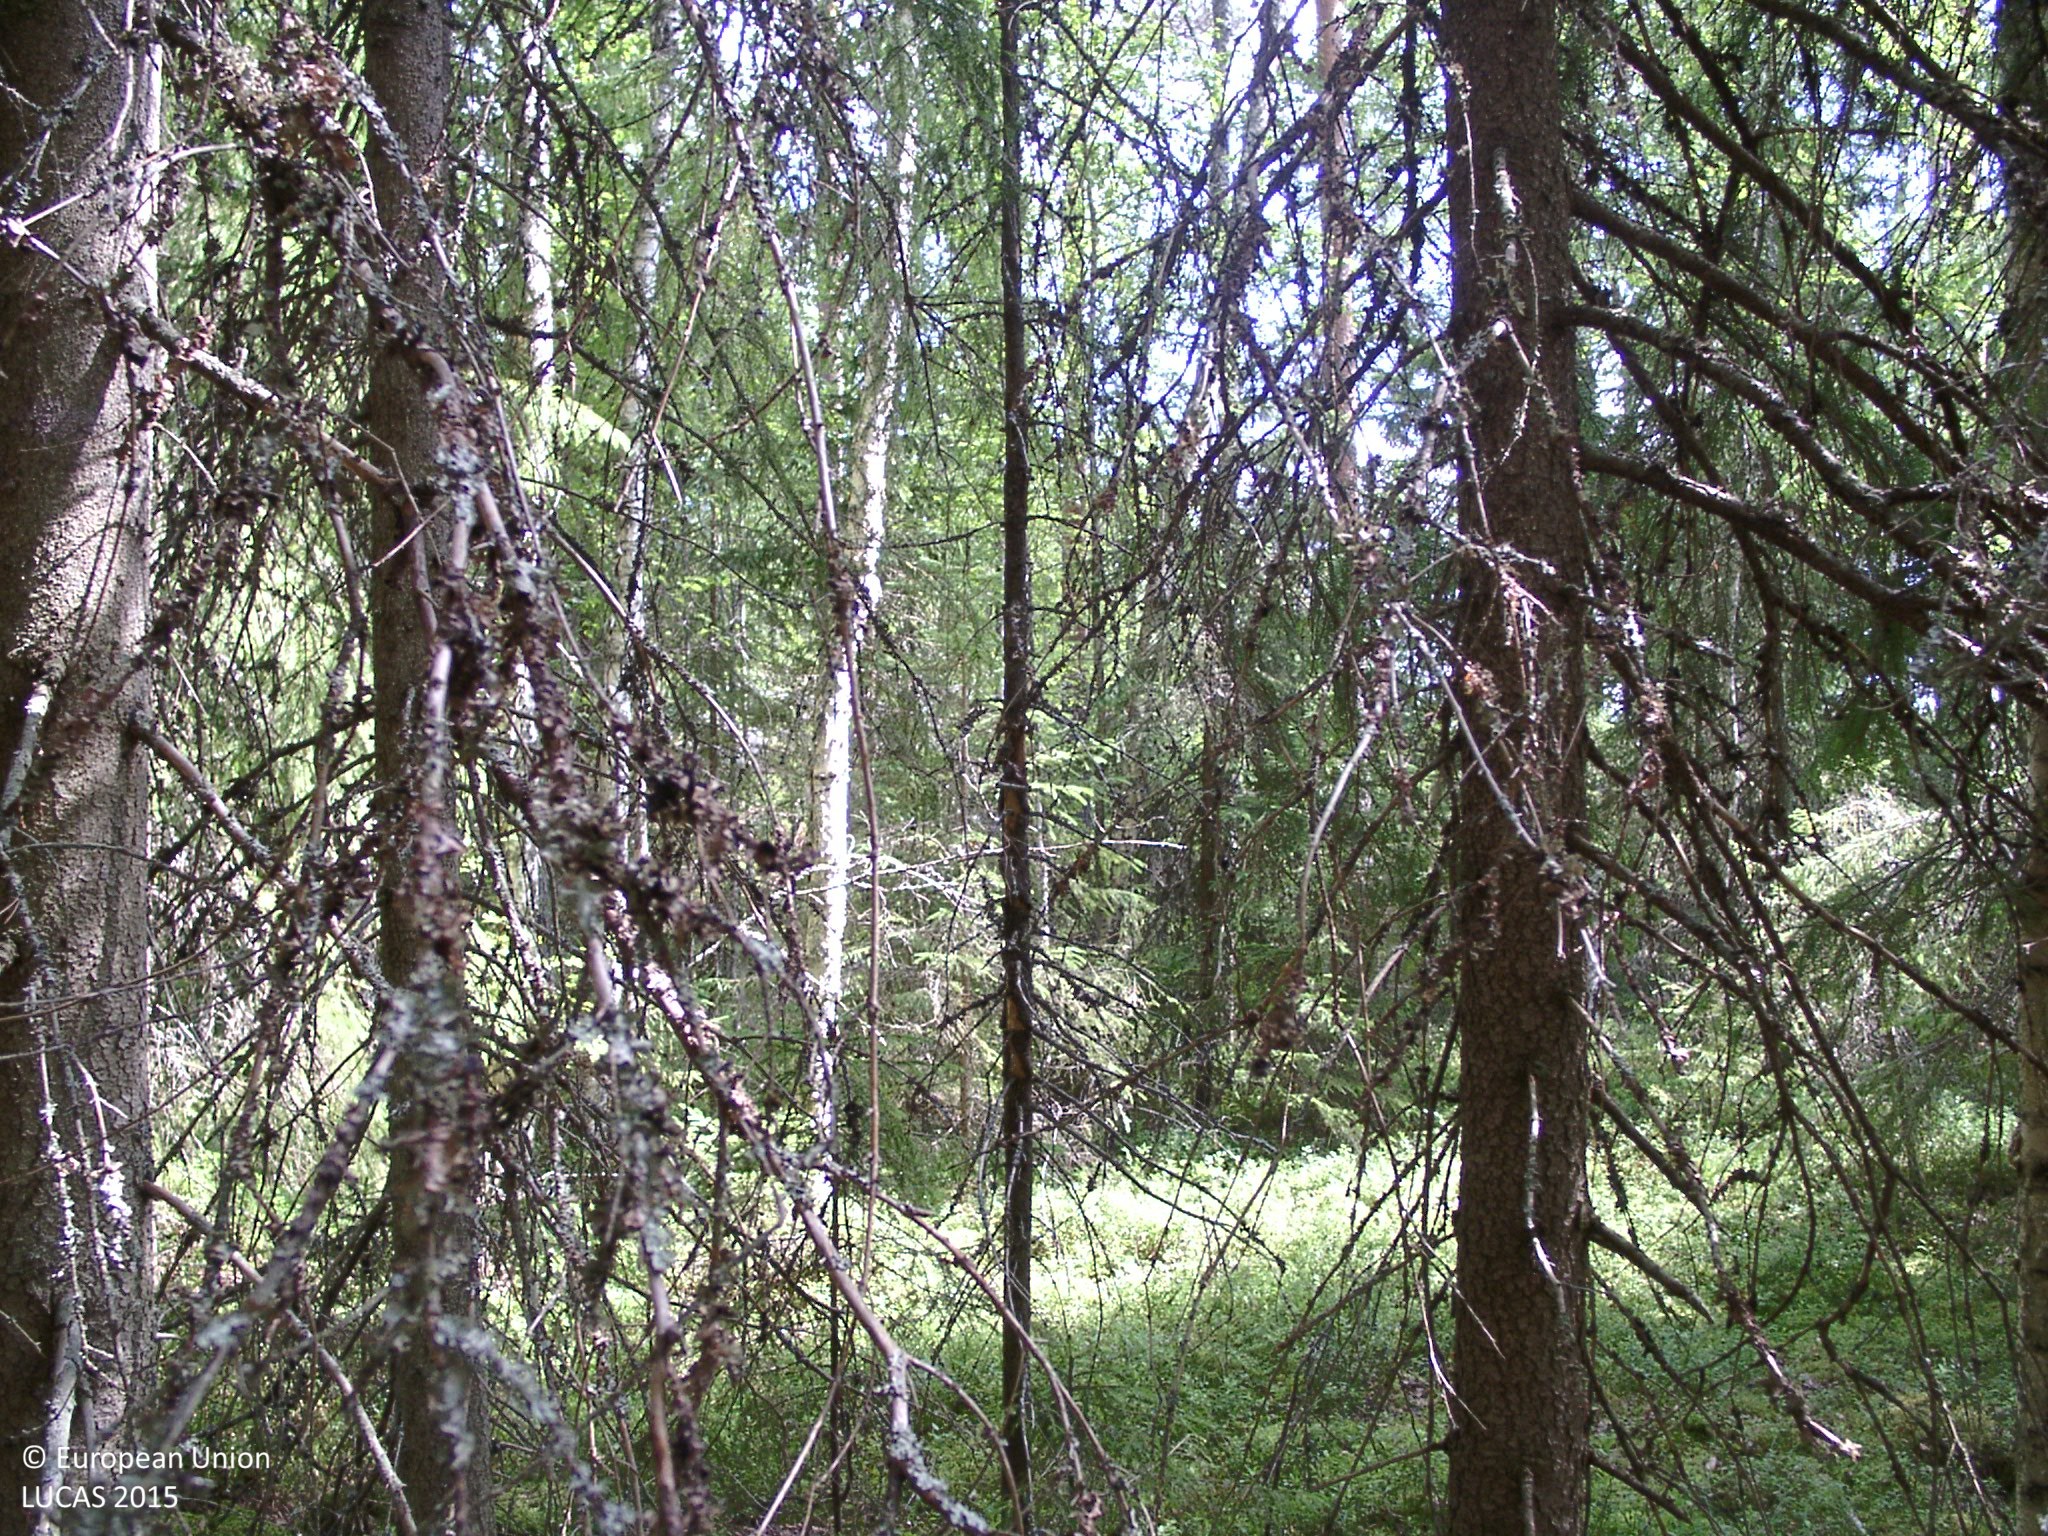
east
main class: Woodland
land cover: Other mixed woodland
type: boreal forest
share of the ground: > 75 %
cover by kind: coniferous forest trees 55 %, broadleaved forest trees 25 %, shrubs 10 %, lichens and mosses 5 %, unconsolidated bare surface 5 %
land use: Semi-natural and natural areas not in use
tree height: > 5 m
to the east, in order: Other mixed woodland; Other coniferous woodland; Shrubland with sparse tree cover
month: July
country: FI
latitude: 61.6129
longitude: 25.0233
